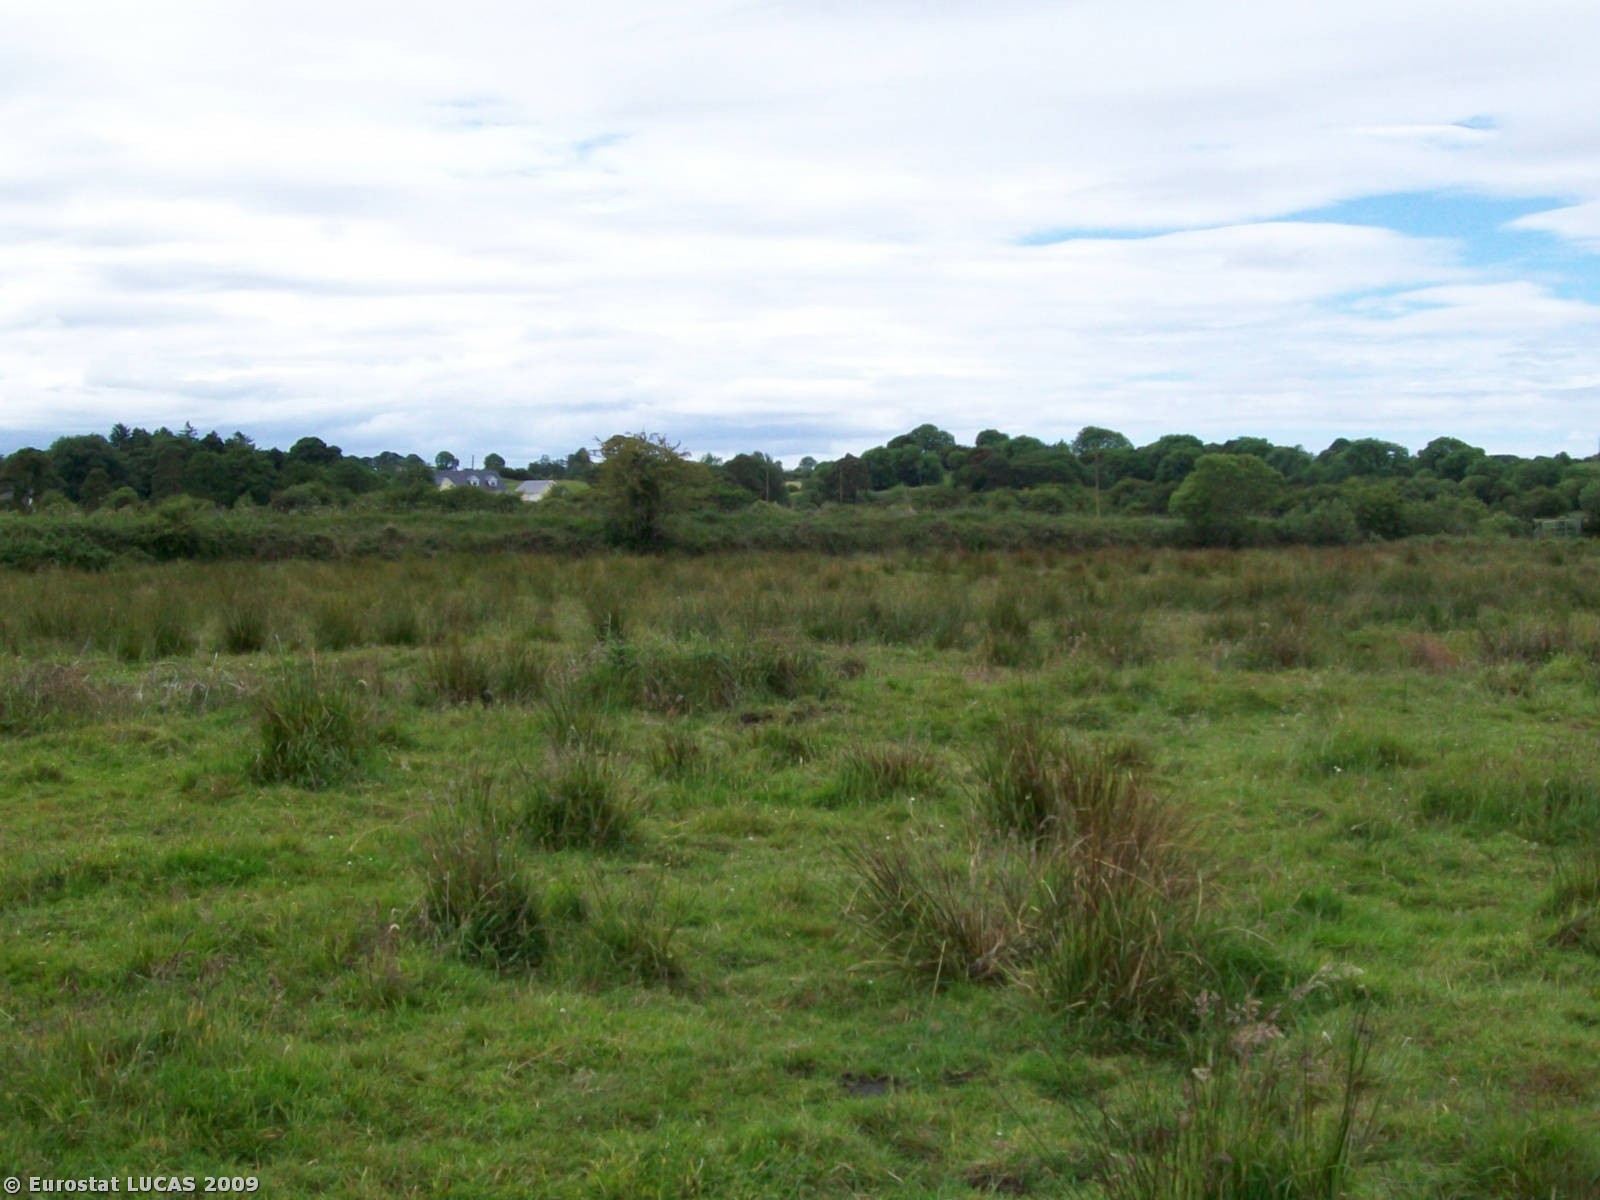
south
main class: Grassland
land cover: Grassland without tree/shrub cover
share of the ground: > 75 %
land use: Agriculture (excluding fallow land and kitchen gardens)
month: June
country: IE
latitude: 53.8153
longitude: -9.0316
